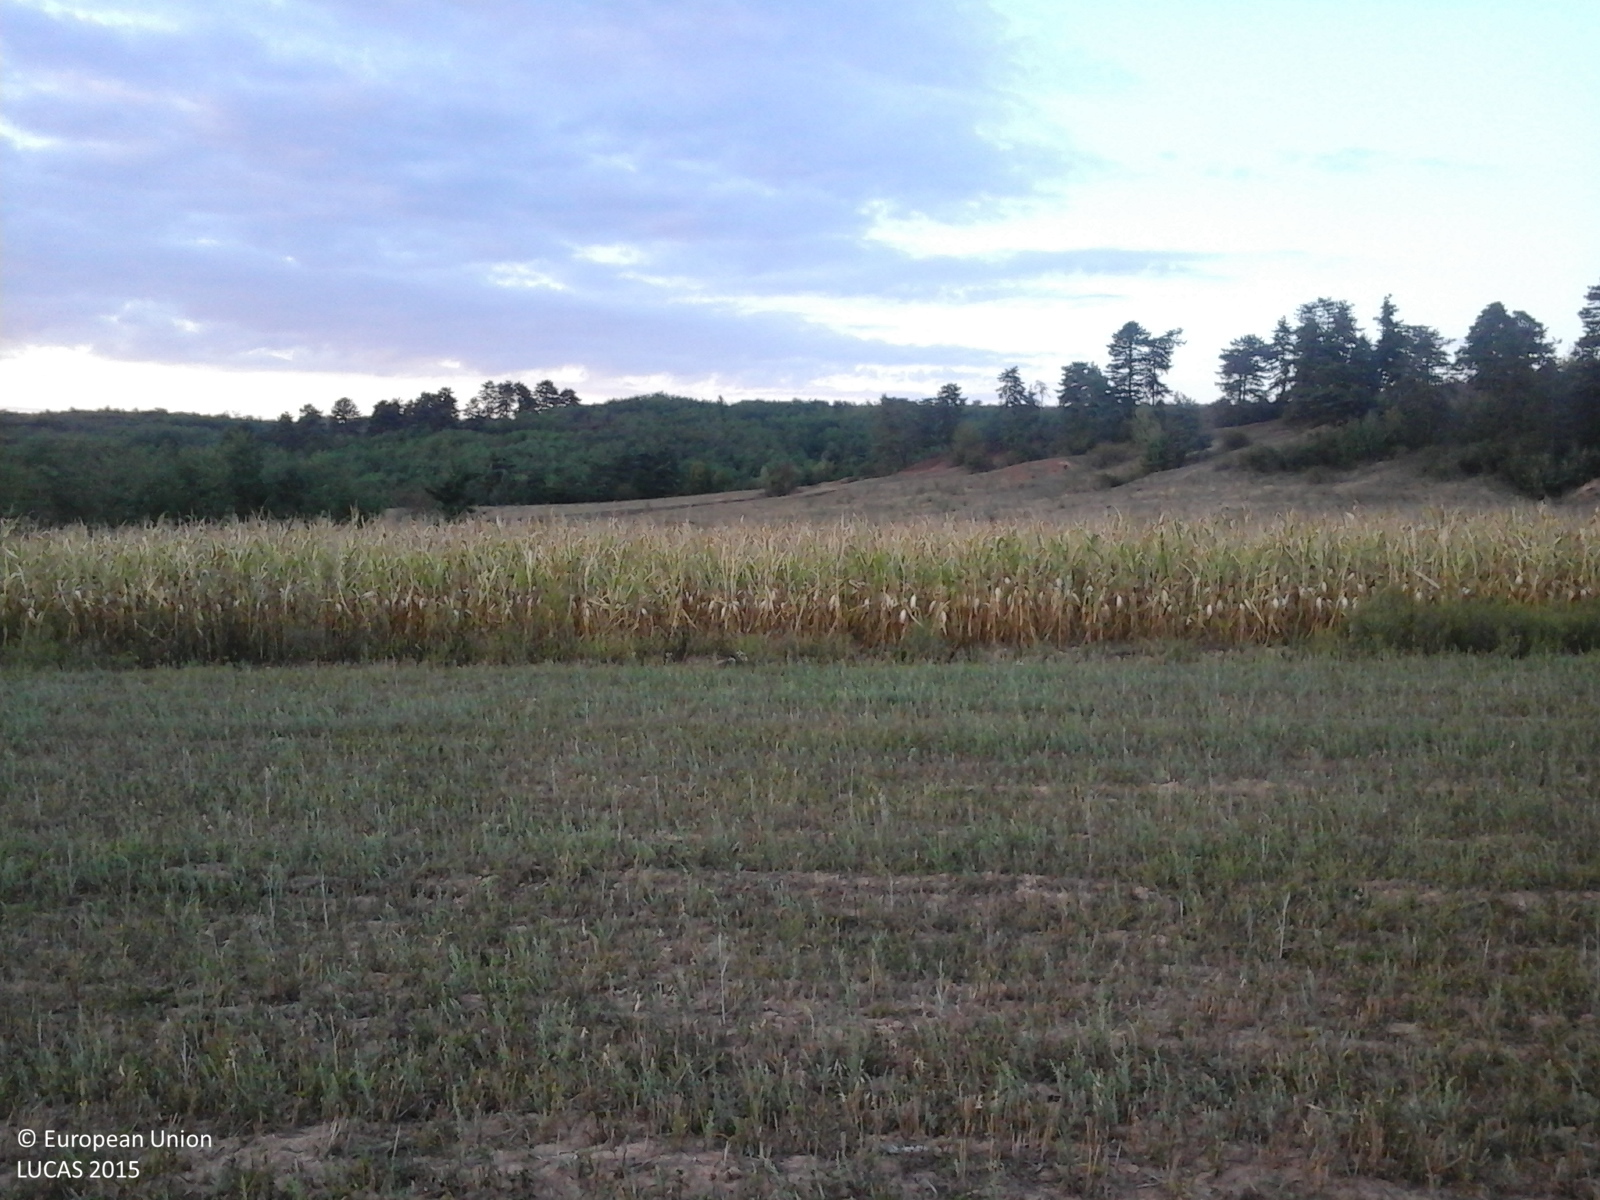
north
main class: Cropland
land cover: Oats
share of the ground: > 75 %
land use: Agriculture (excluding fallow land and kitchen gardens)
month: September
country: RO
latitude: 47.3382
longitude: 23.3175
